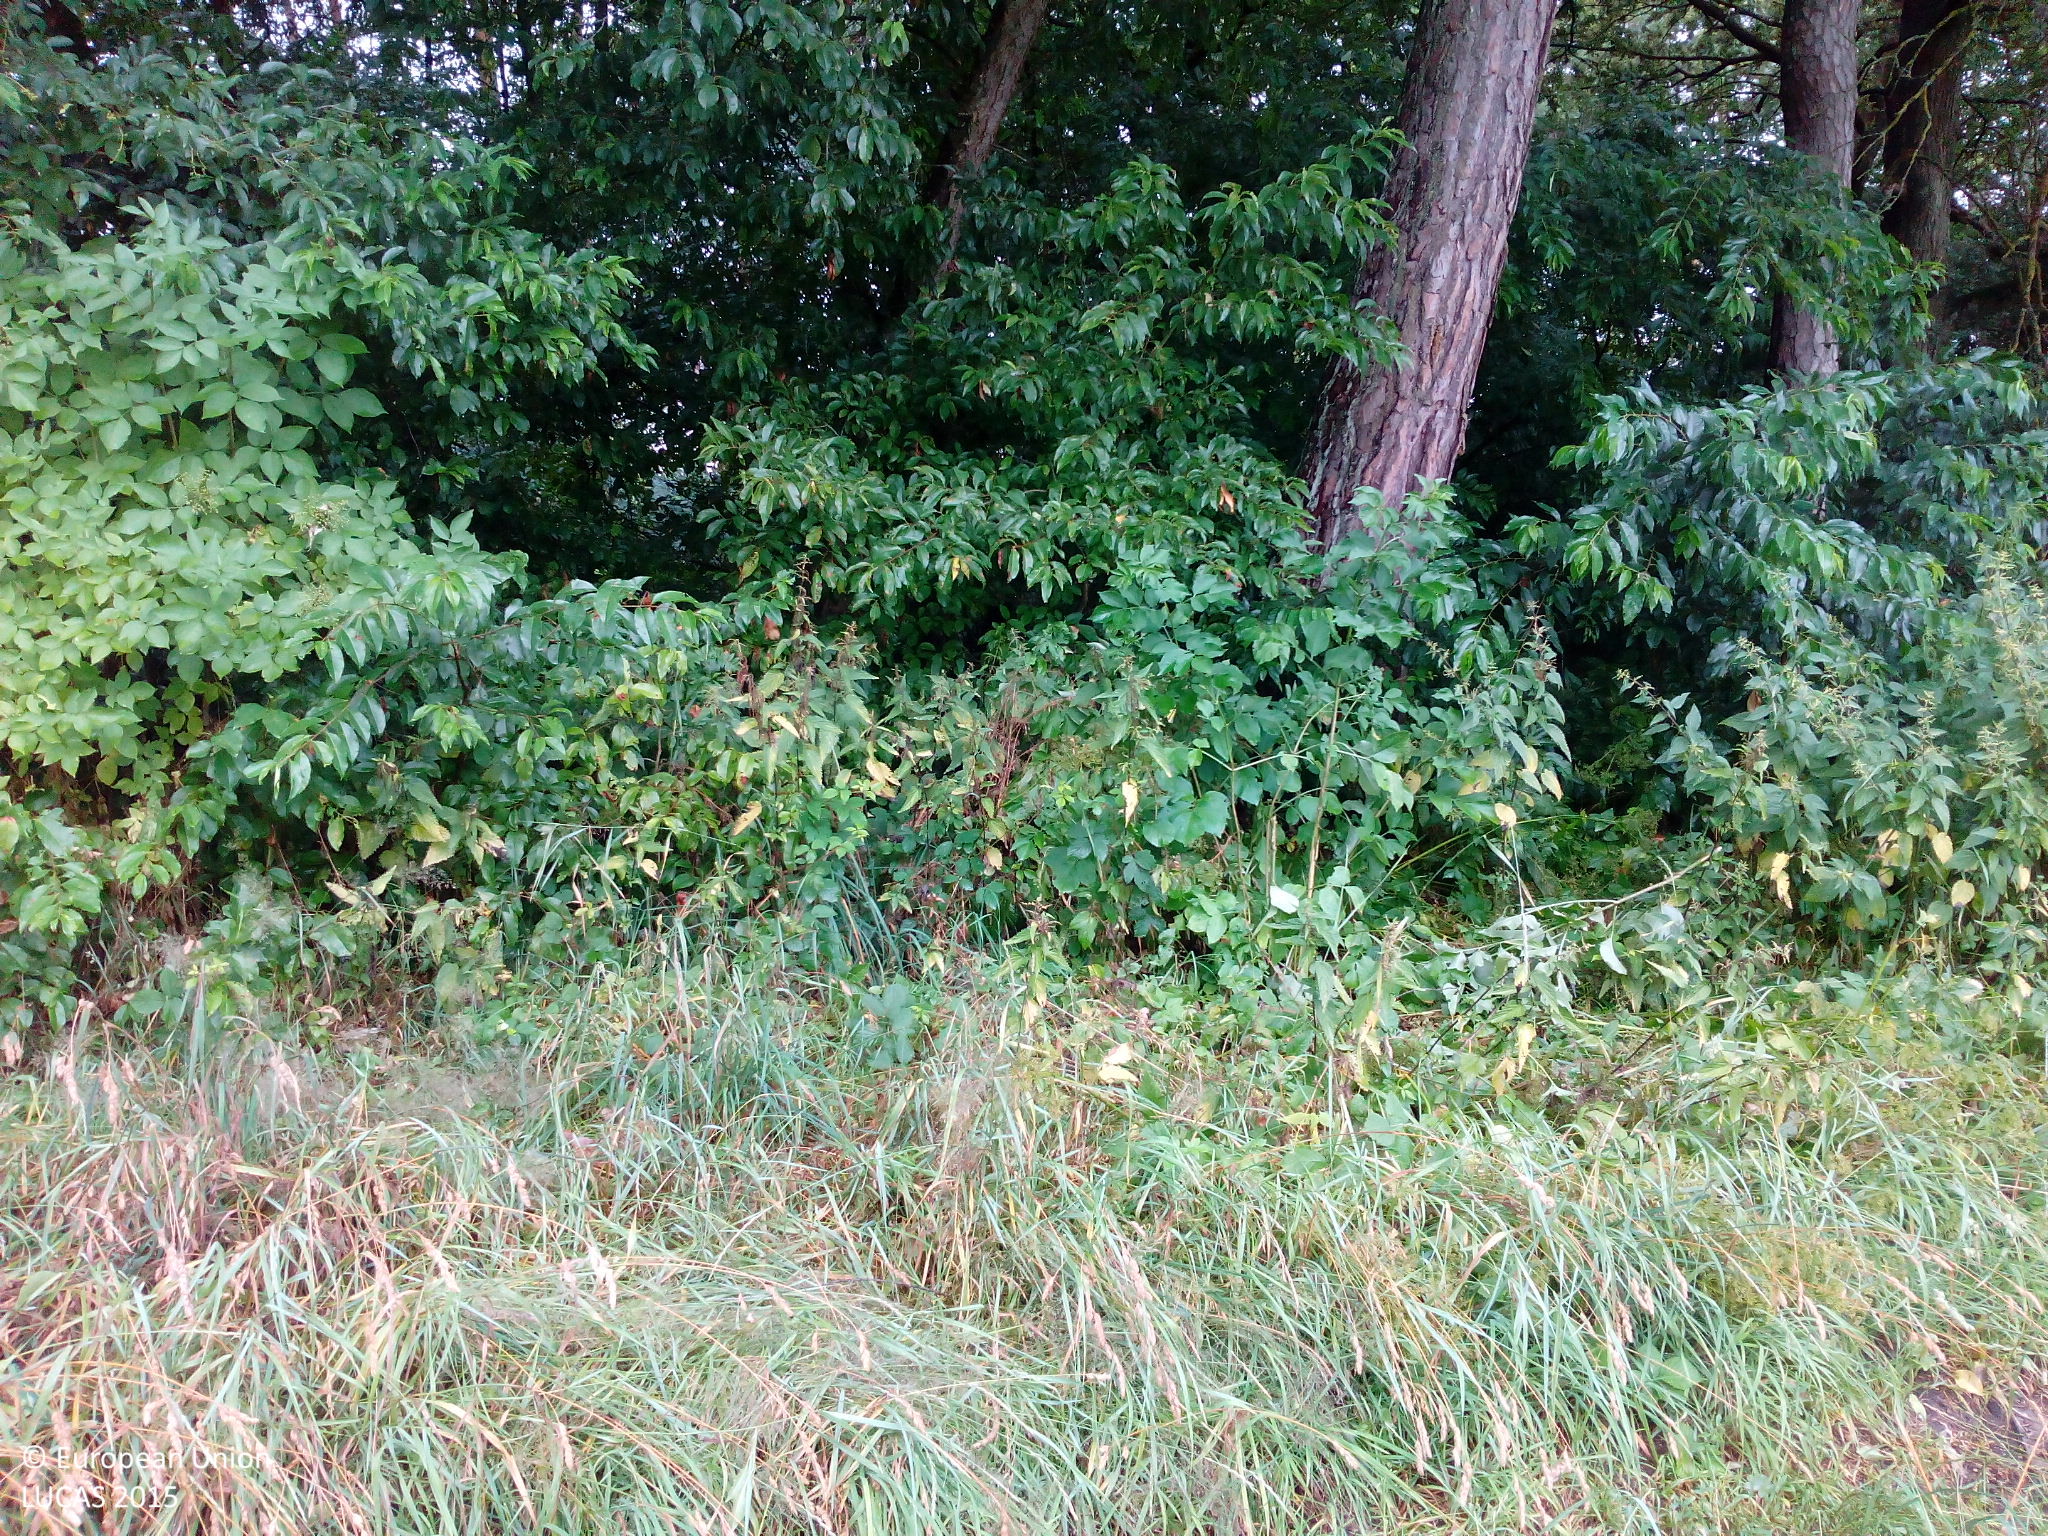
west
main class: Cropland
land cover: Potatoes
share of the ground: > 75 %
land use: Agriculture (excluding fallow land and kitchen gardens)
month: July
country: DE
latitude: 48.6463
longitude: 11.4245
